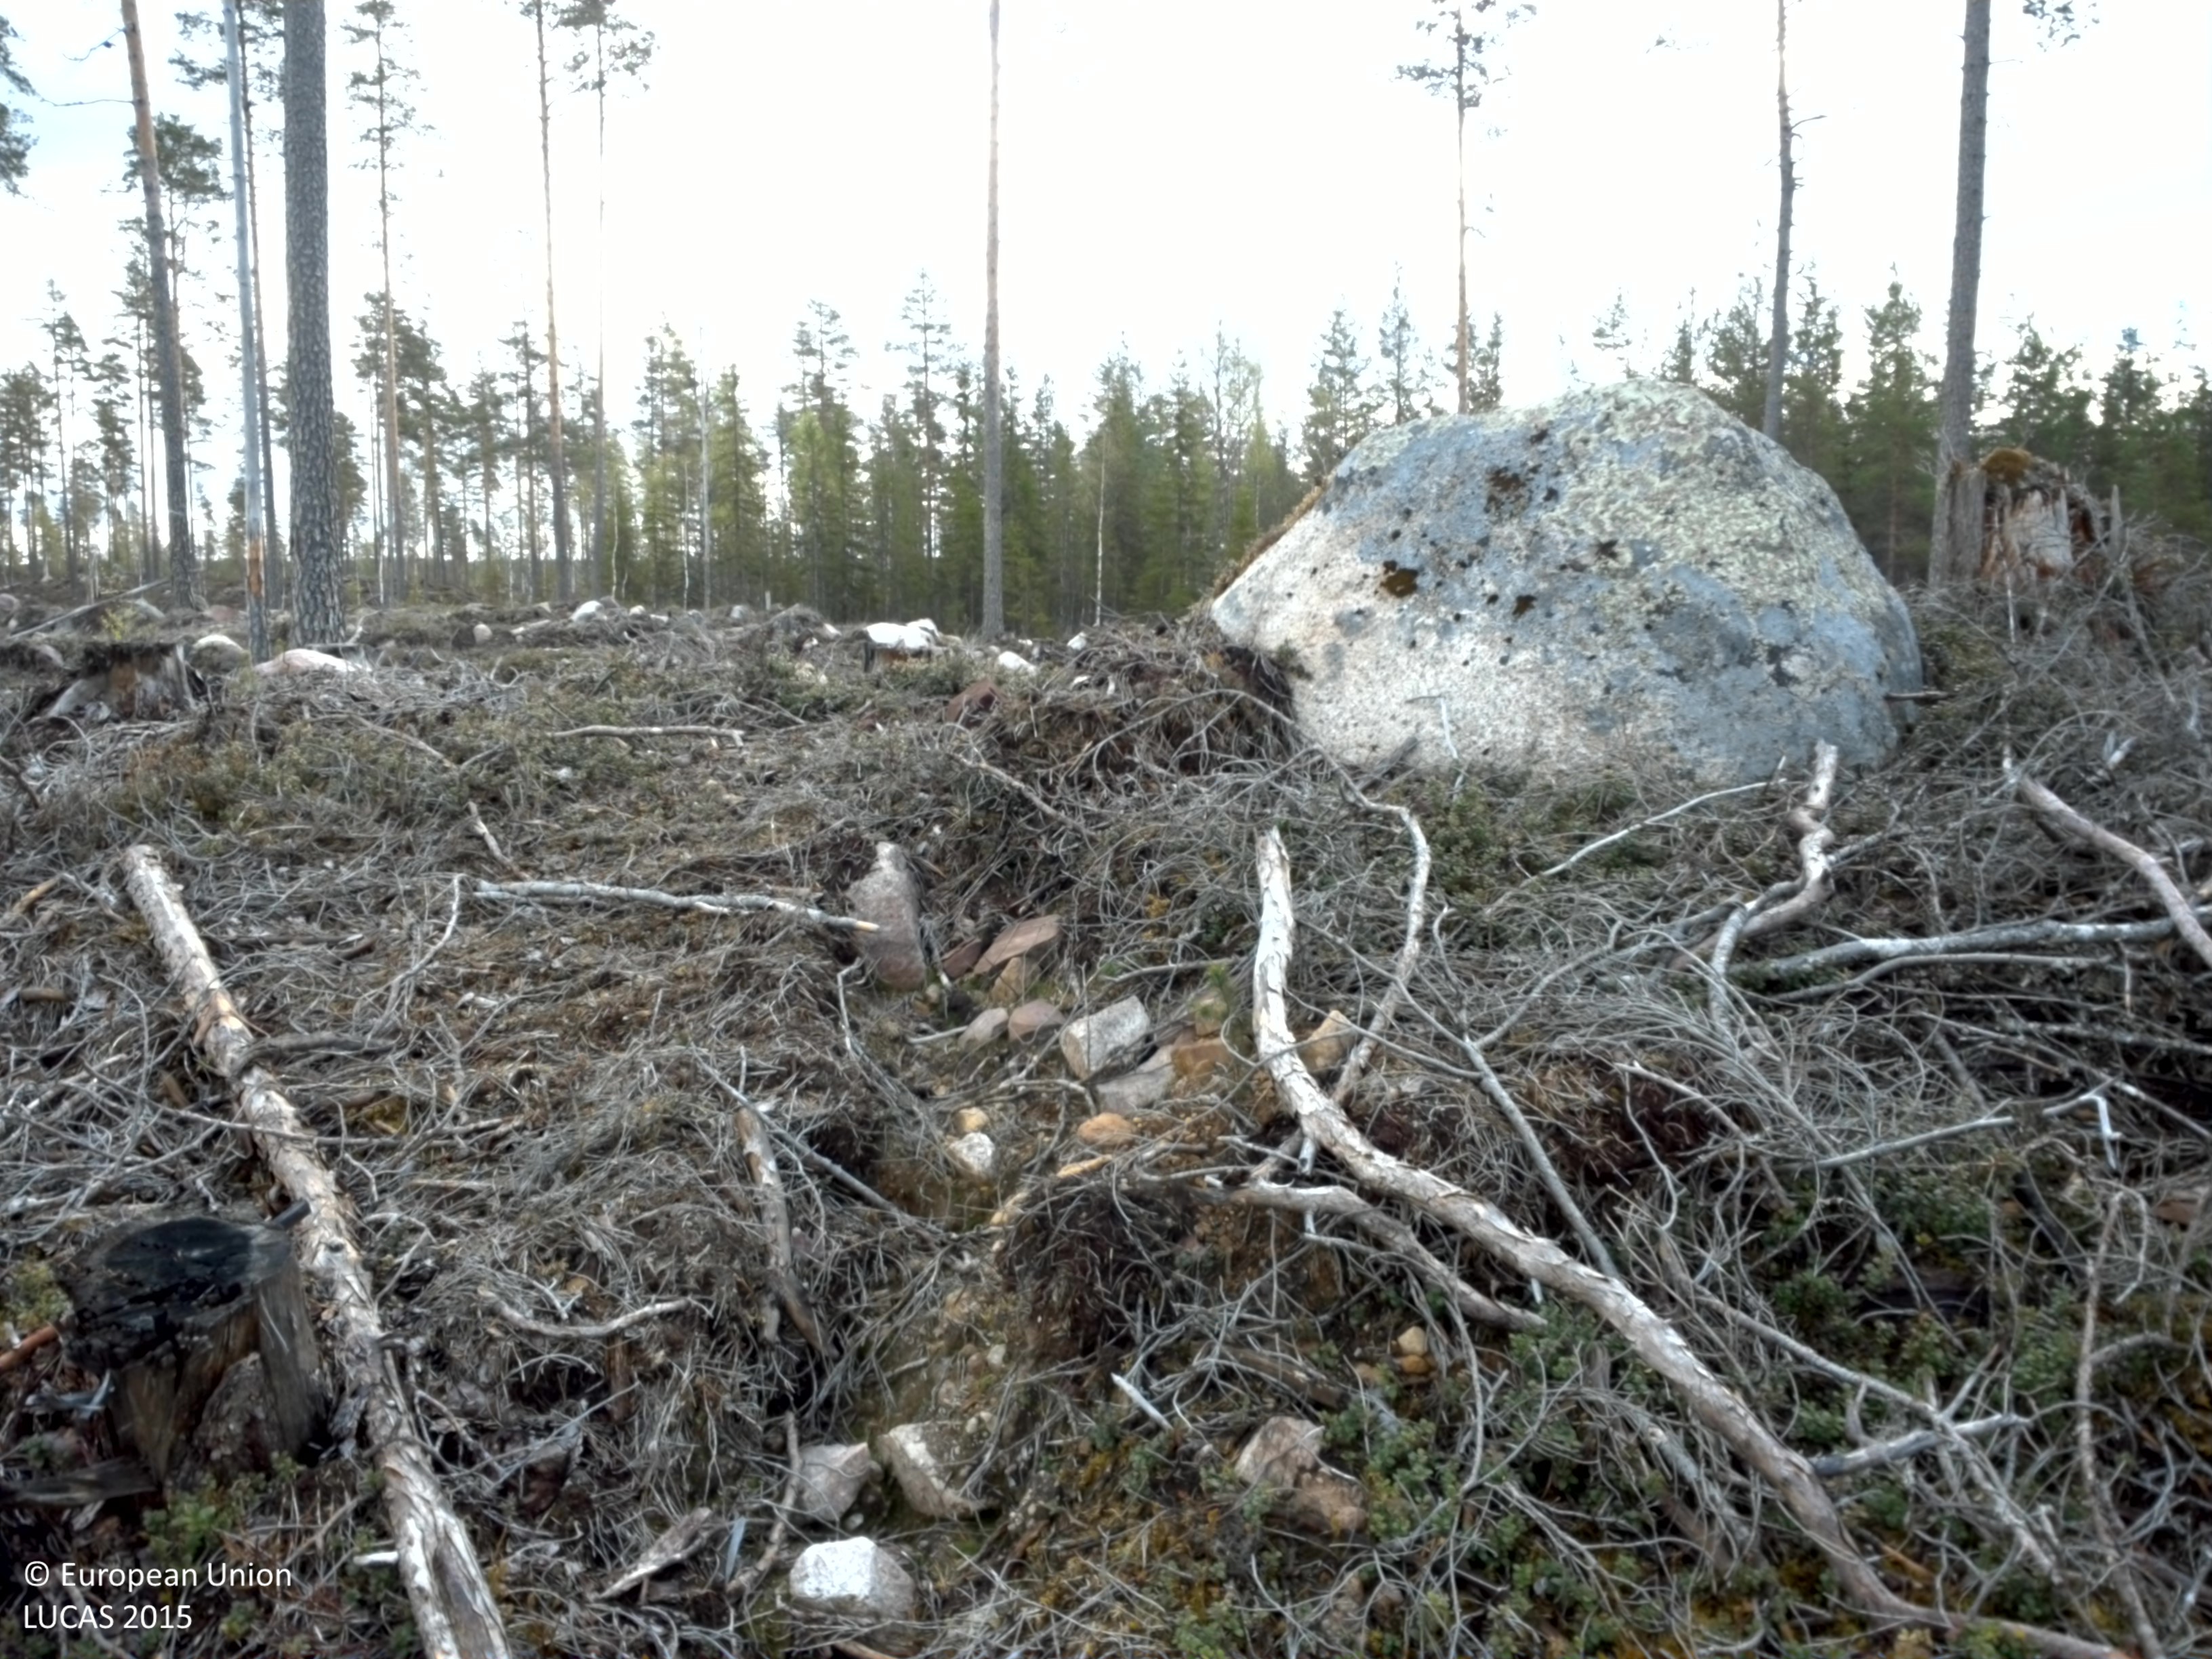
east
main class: Shrubland
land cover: Shrubland with sparse tree cover
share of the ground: 10 - 25 %
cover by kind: shrubs 10 %, herbaceous plants 10 %, coniferous forest trees 5 %, lichens and mosses 5 %
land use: Forestry
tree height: > 5 m
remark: Clear cut
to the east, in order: Shrubland with sparse tree cover; Spruce dominated mixed woodland; Shrubland with sparse tree cover
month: May
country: SE
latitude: 60.3358
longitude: 13.4861
